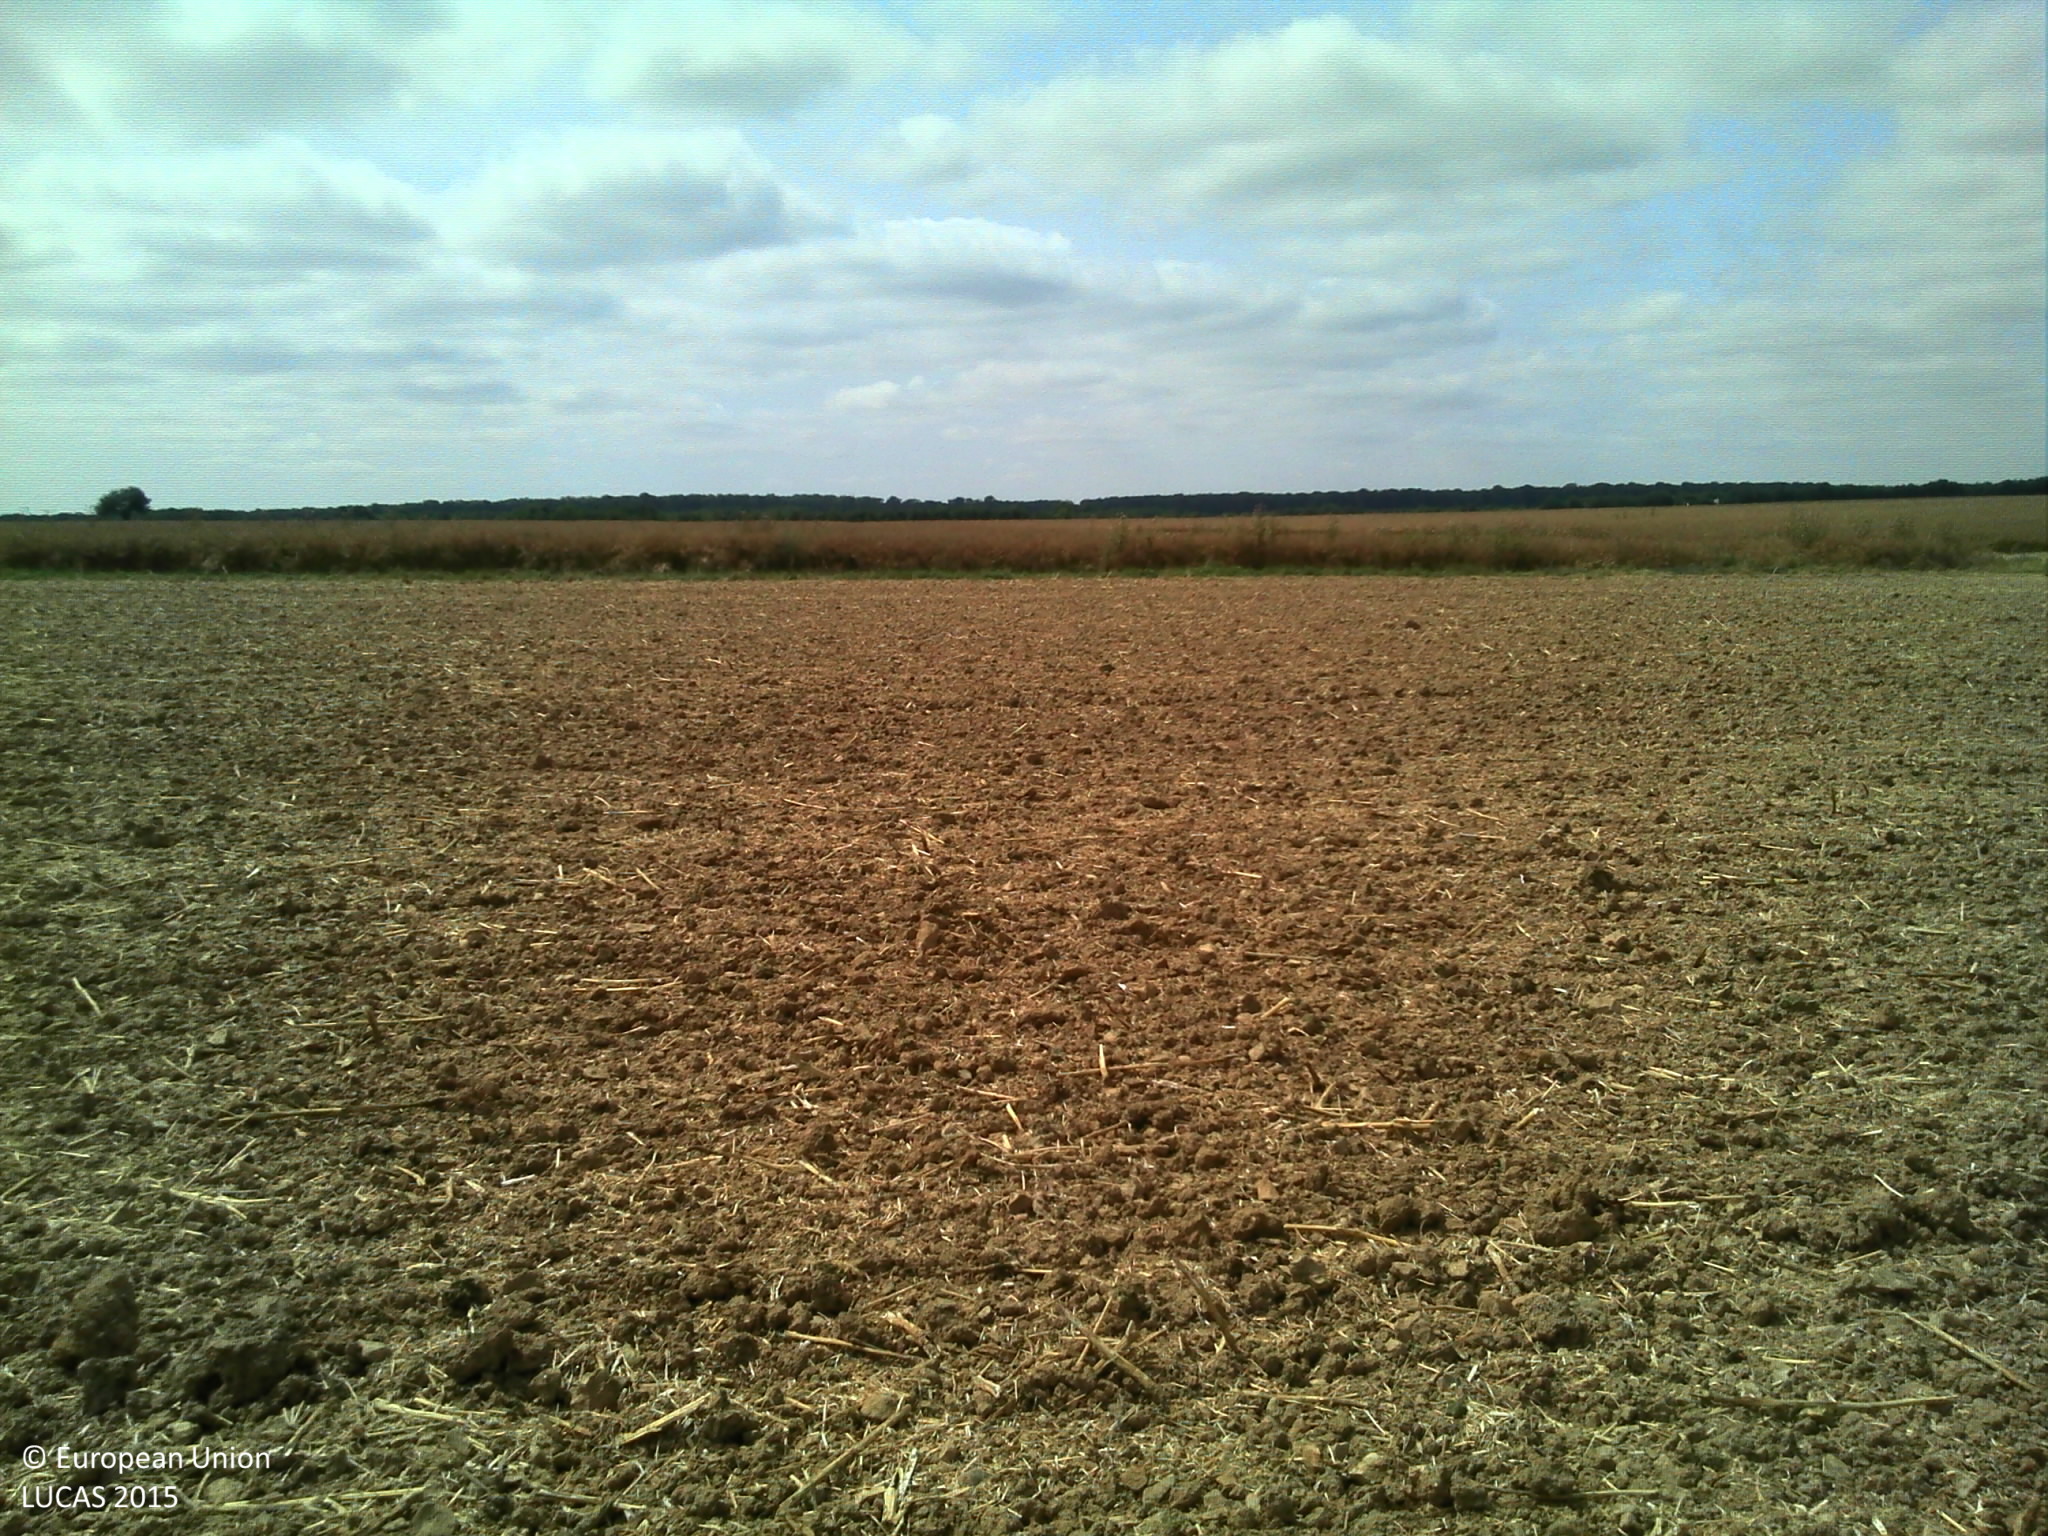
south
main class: Cropland
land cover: Rape and turnip rape
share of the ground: < 10 %
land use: Agriculture (excluding fallow land and kitchen gardens)
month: July
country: FR
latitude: 46.6230
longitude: 0.1714
